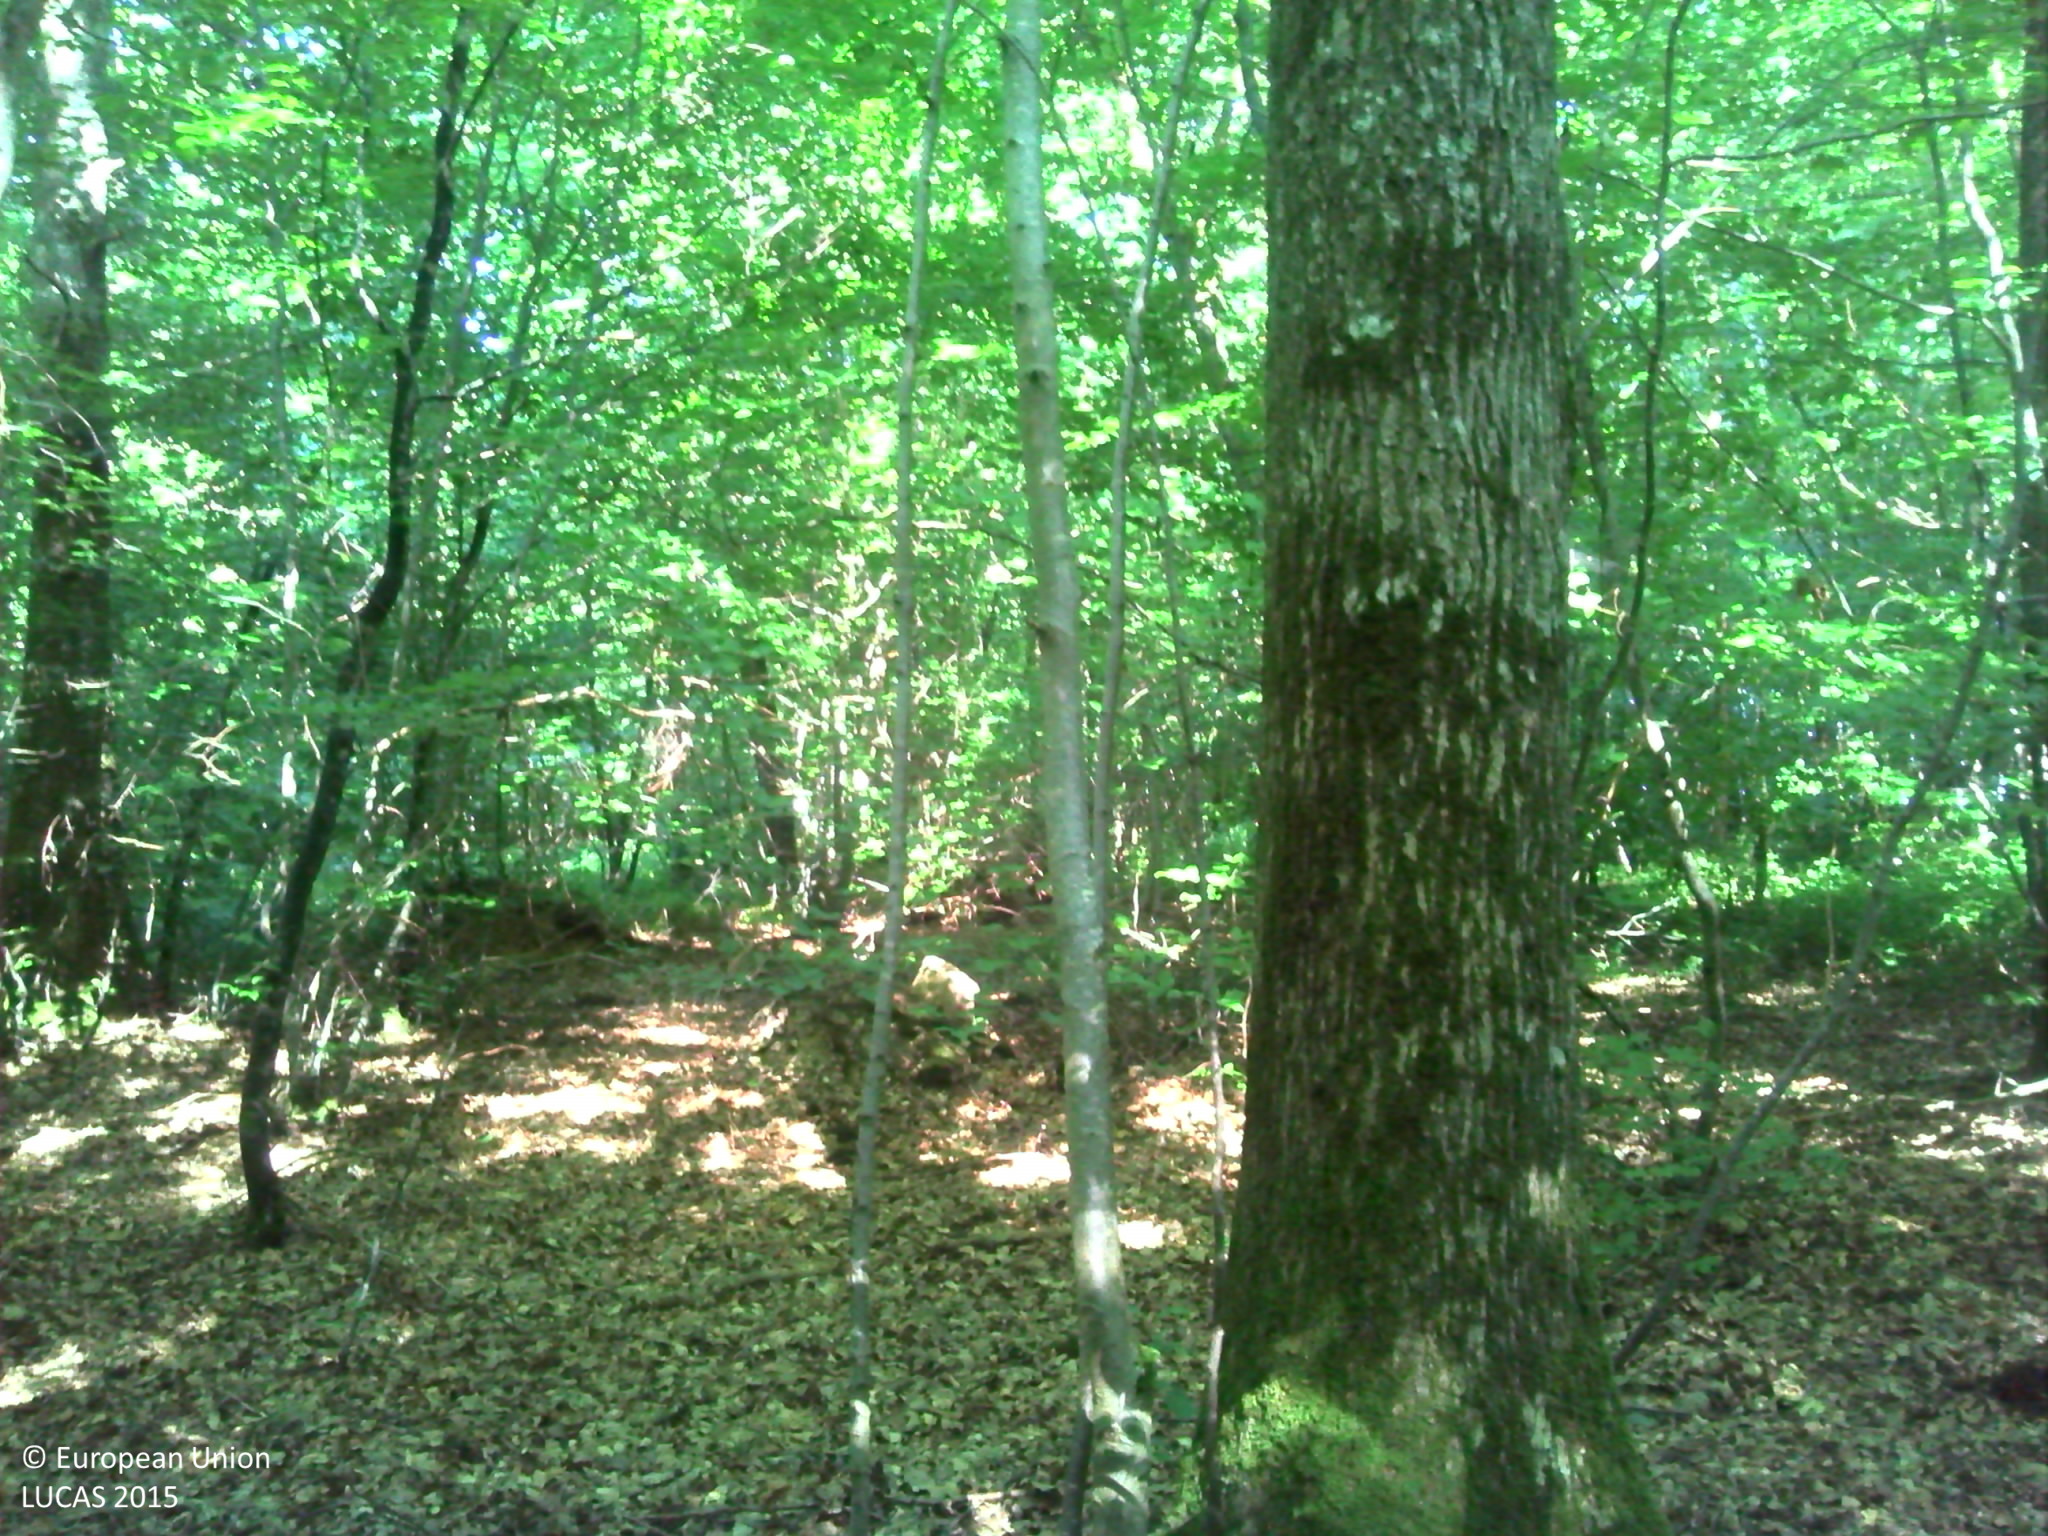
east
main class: Woodland
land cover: Broadleaved woodland
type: acidophilous oak and oak-birch forest
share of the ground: > 75 %
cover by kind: broadleaved forest trees 70 %, herbaceous plants 15 %, consolidated bare surface 15 %
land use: Forestry
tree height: > 5 m
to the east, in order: Broadleaved woodland; Fences; Grassland without tree/shrub cover
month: July
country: FR
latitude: 49.0620
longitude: 0.7105
